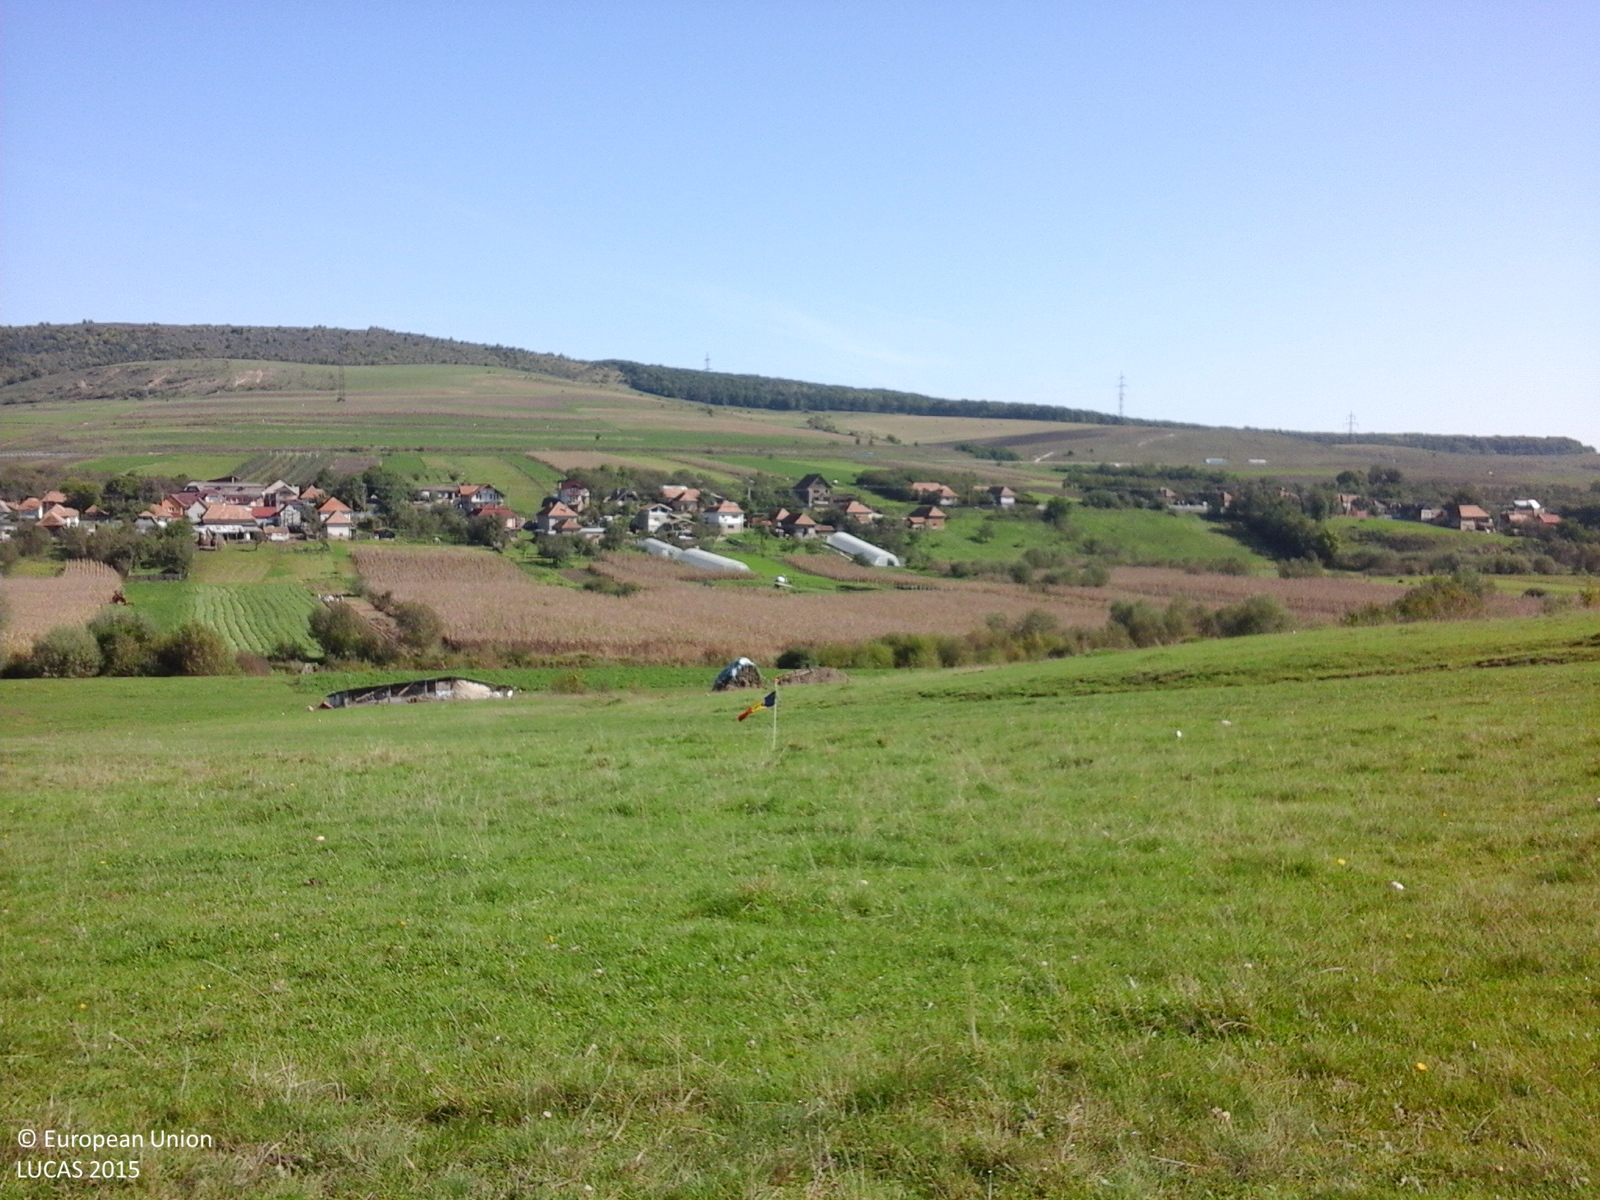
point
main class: Grassland
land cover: Grassland without tree/shrub cover
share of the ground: > 75 %
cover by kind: herbaceous plants 100 %
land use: Agriculture (excluding fallow land and kitchen gardens)
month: October
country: RO
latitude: 46.6115
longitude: 23.5838
